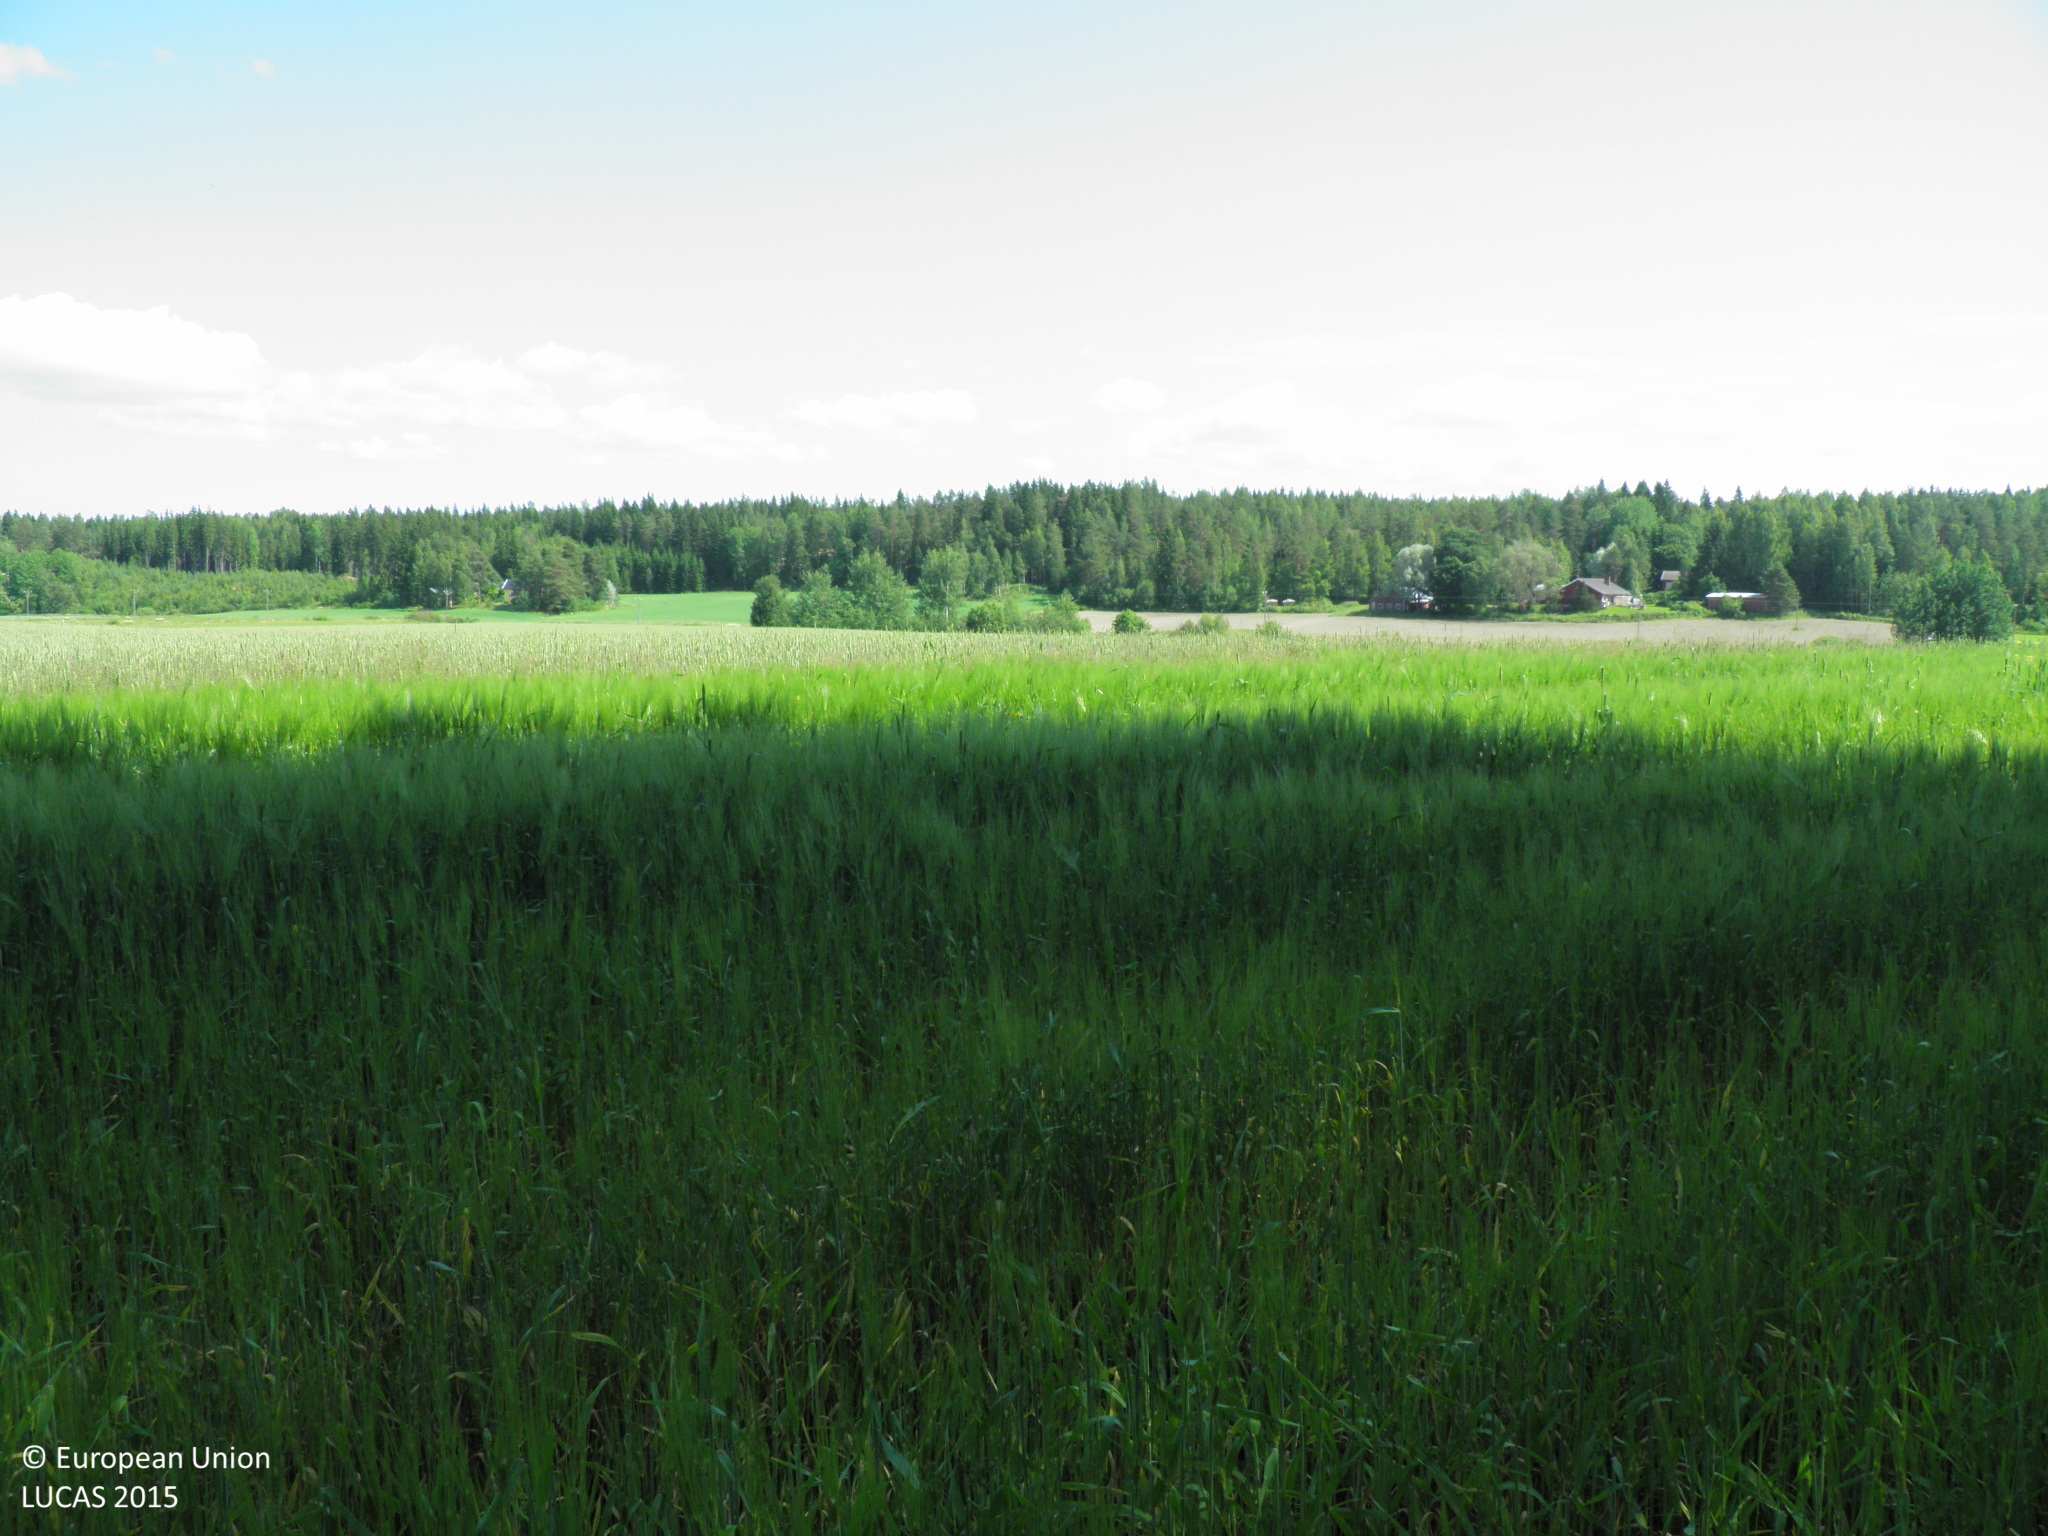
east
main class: Cropland
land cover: Barley
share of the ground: > 75 %
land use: Agriculture (excluding fallow land and kitchen gardens)
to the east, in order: Barley; Common wheat; Grassland without tree/shrub cover; Inland fresh running water; Grassland without tree/shrub cover; Arable land (only in case pi)
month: July
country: FI
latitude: 60.8820
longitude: 22.5030
